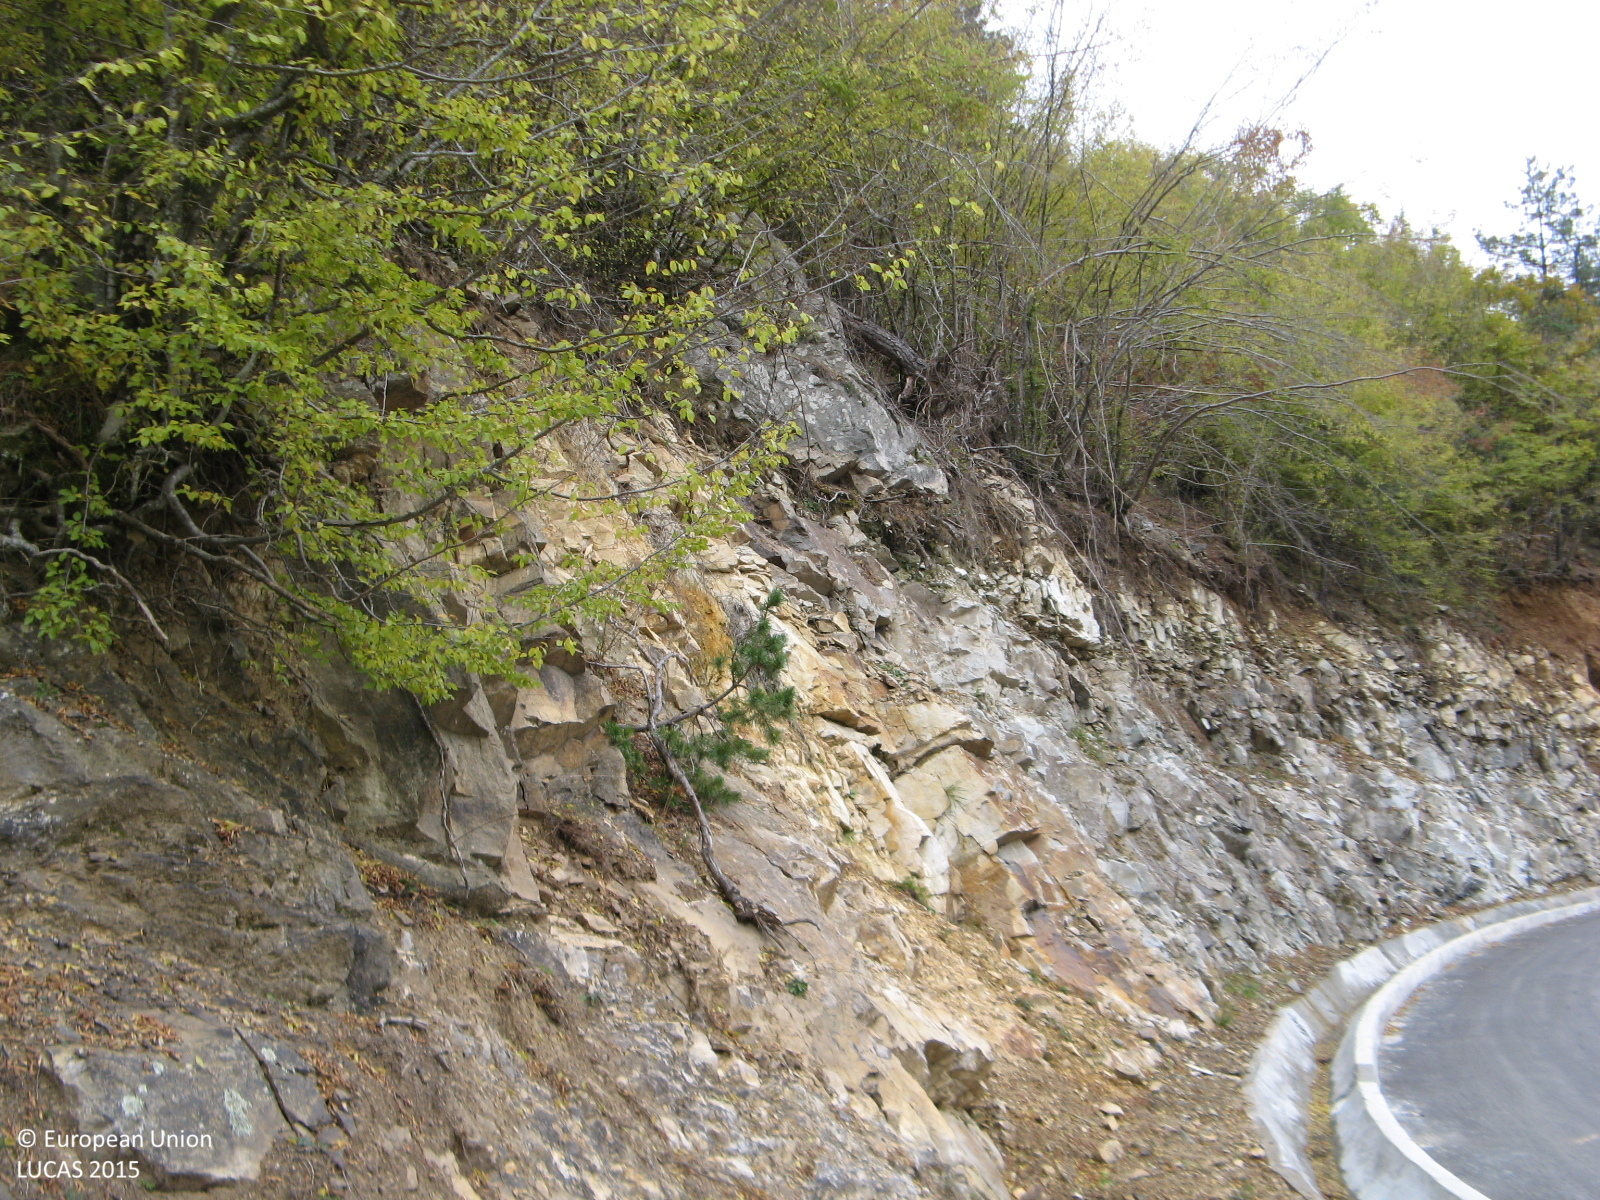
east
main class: Shrubland
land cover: Shrubland with sparse tree cover
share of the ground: > 75 %
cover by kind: shrubs 90 %, broadleaved forest trees 5 %, herbaceous plants 5 %
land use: Semi-natural and natural areas not in use
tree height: < 5 m
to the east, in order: Shrubland with sparse tree cover; Rivers and streams; Shrubland with sparse tree cover
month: October
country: BG
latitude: 41.4704
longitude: 25.0277
